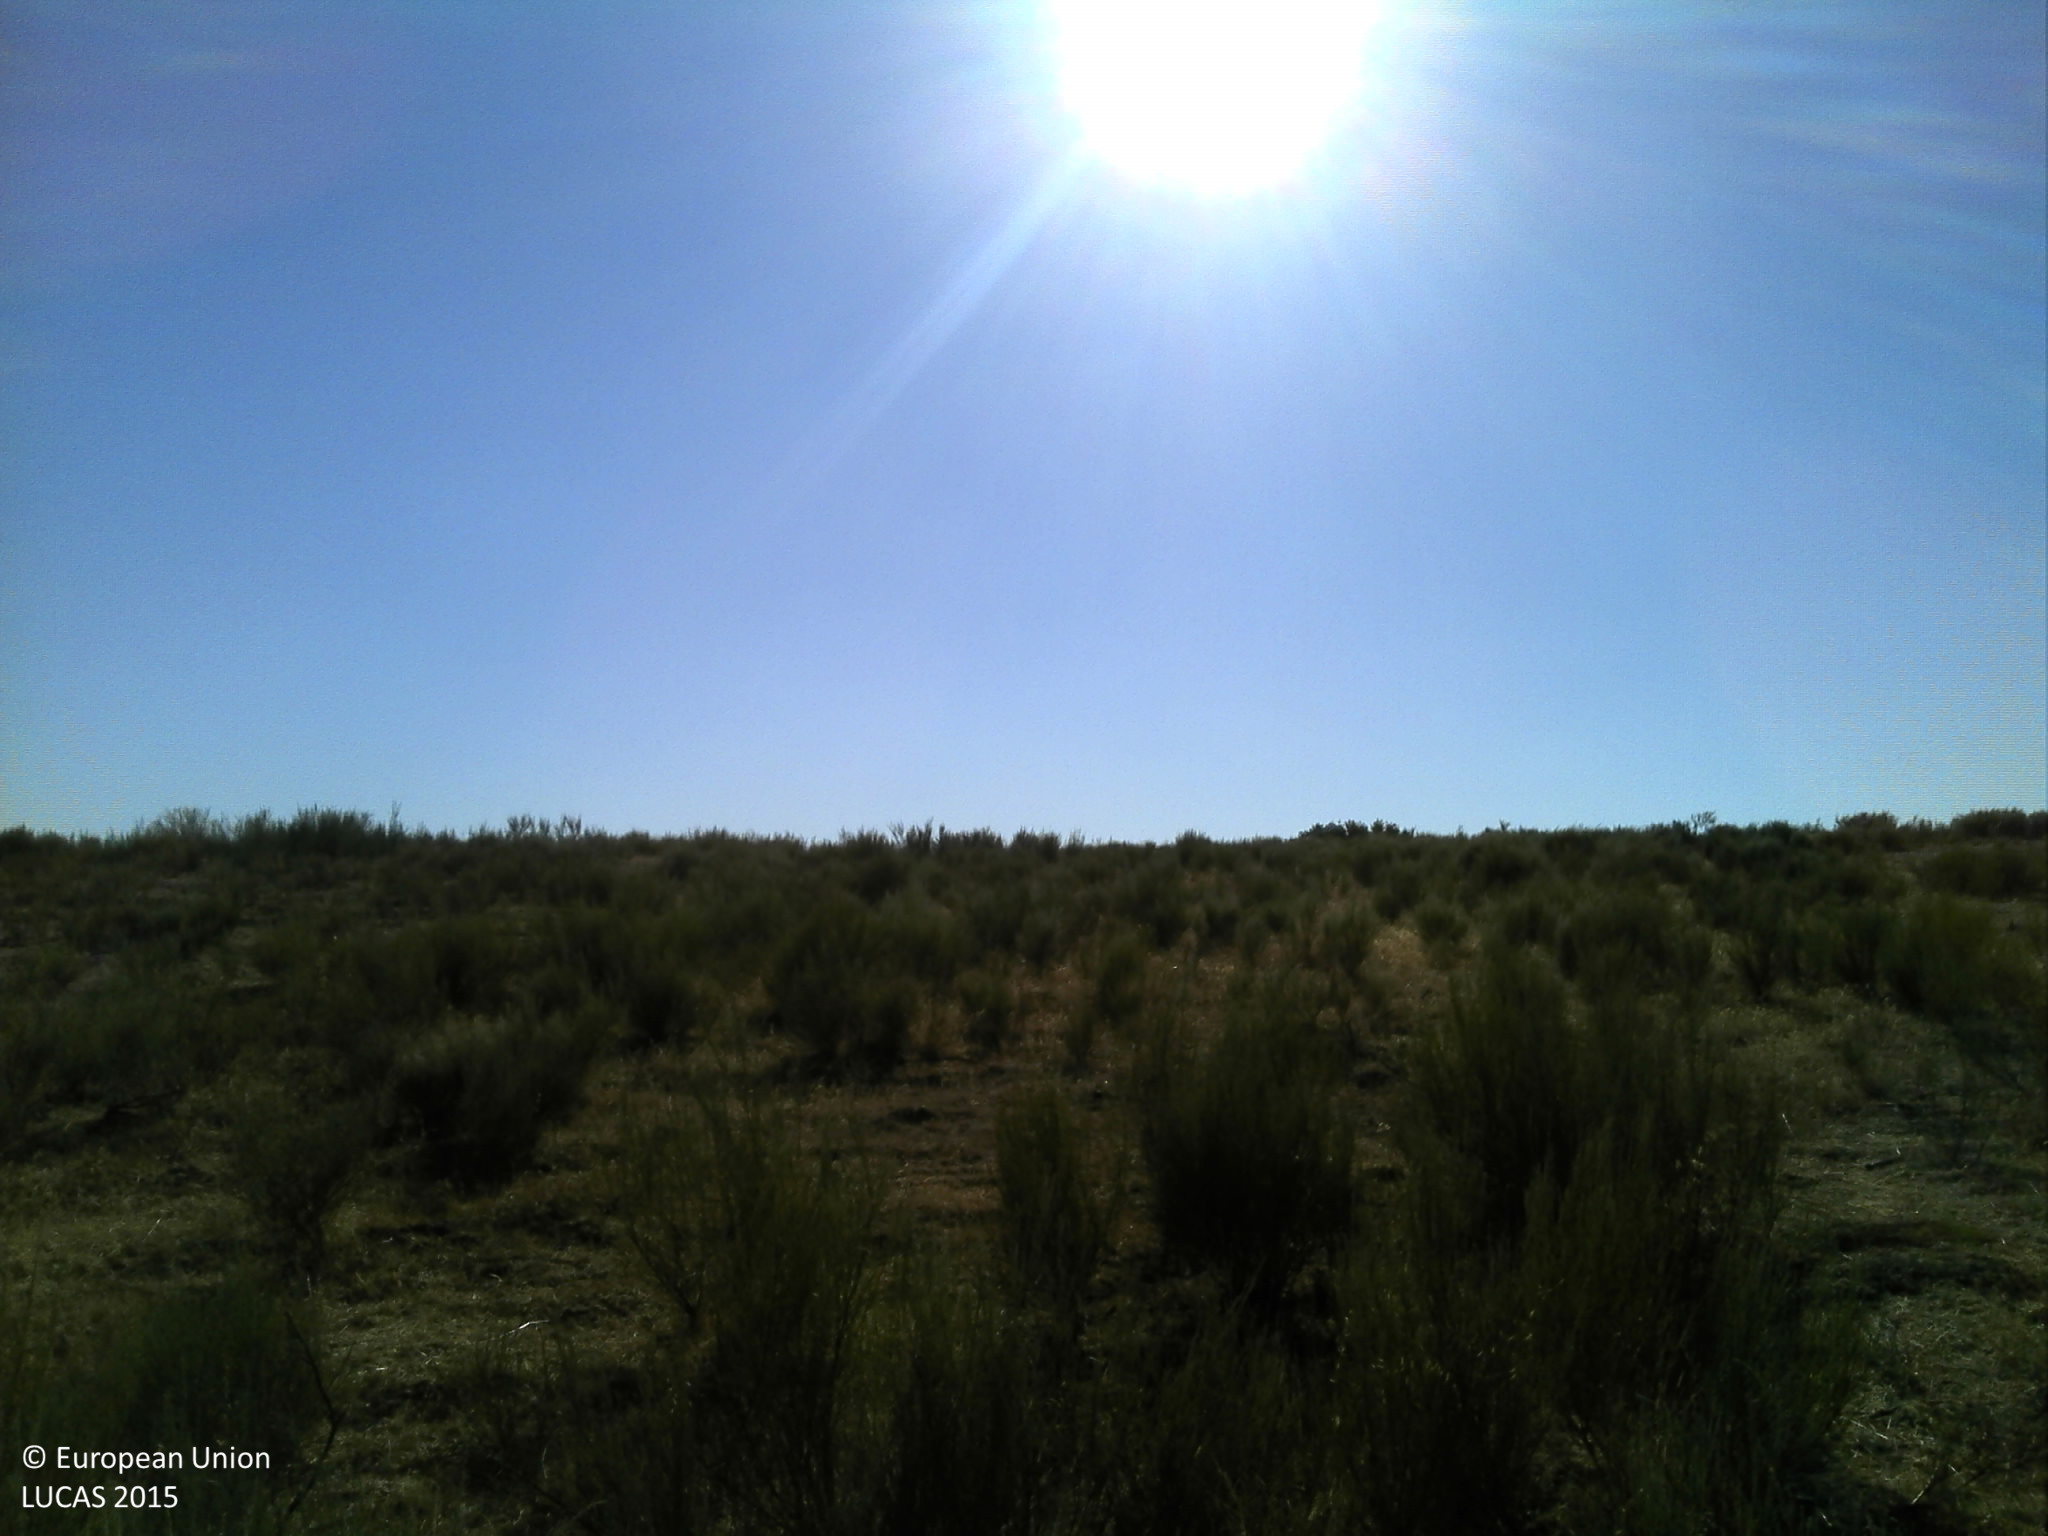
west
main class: Shrubland
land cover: Shrubland without tree cover
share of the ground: 25 - 50 %
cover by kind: unconsolidated bare surface 50 %, shrubs 30 %, herbaceous plants 20 %
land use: Agriculture (excluding fallow land and kitchen gardens)
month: August
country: PT
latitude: 39.4360
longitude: -7.5082
